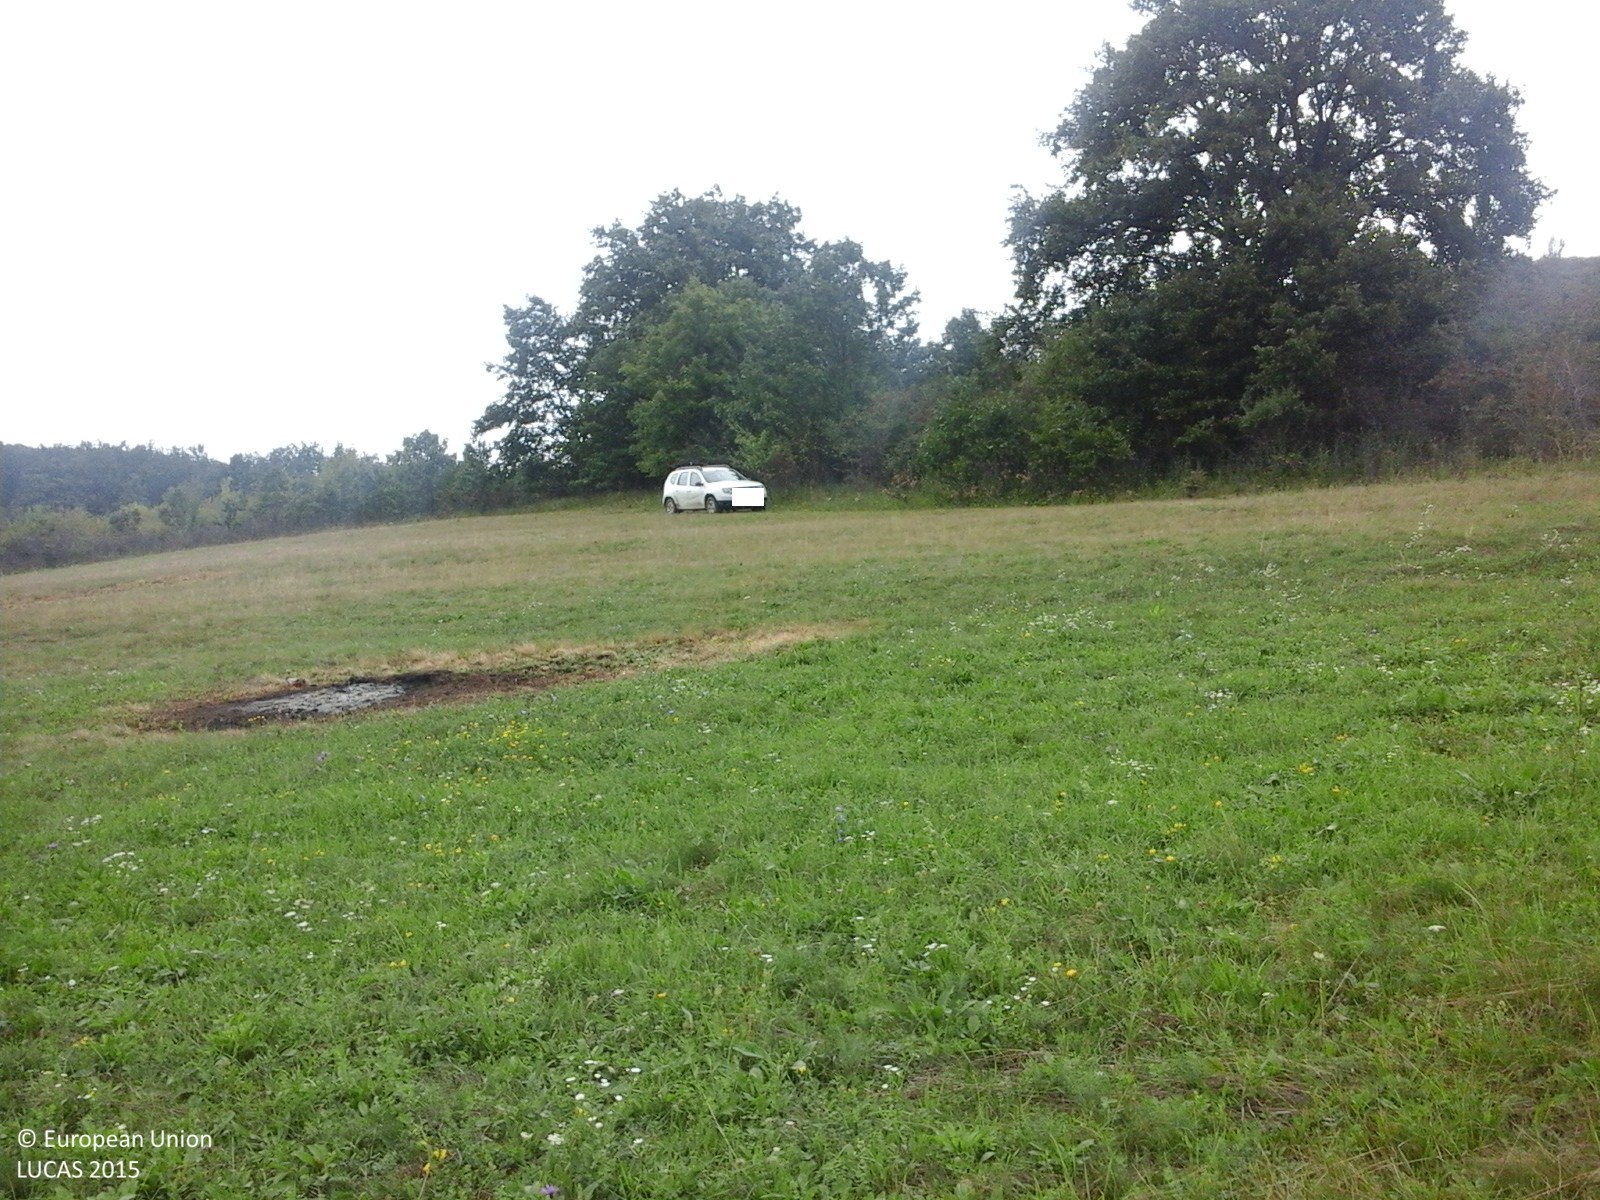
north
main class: Grassland
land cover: Grassland without tree/shrub cover
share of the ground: > 75 %
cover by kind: herbaceous plants 100 %
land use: Agriculture (excluding fallow land and kitchen gardens)
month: September
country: RO
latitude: 46.9983
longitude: 22.3479
